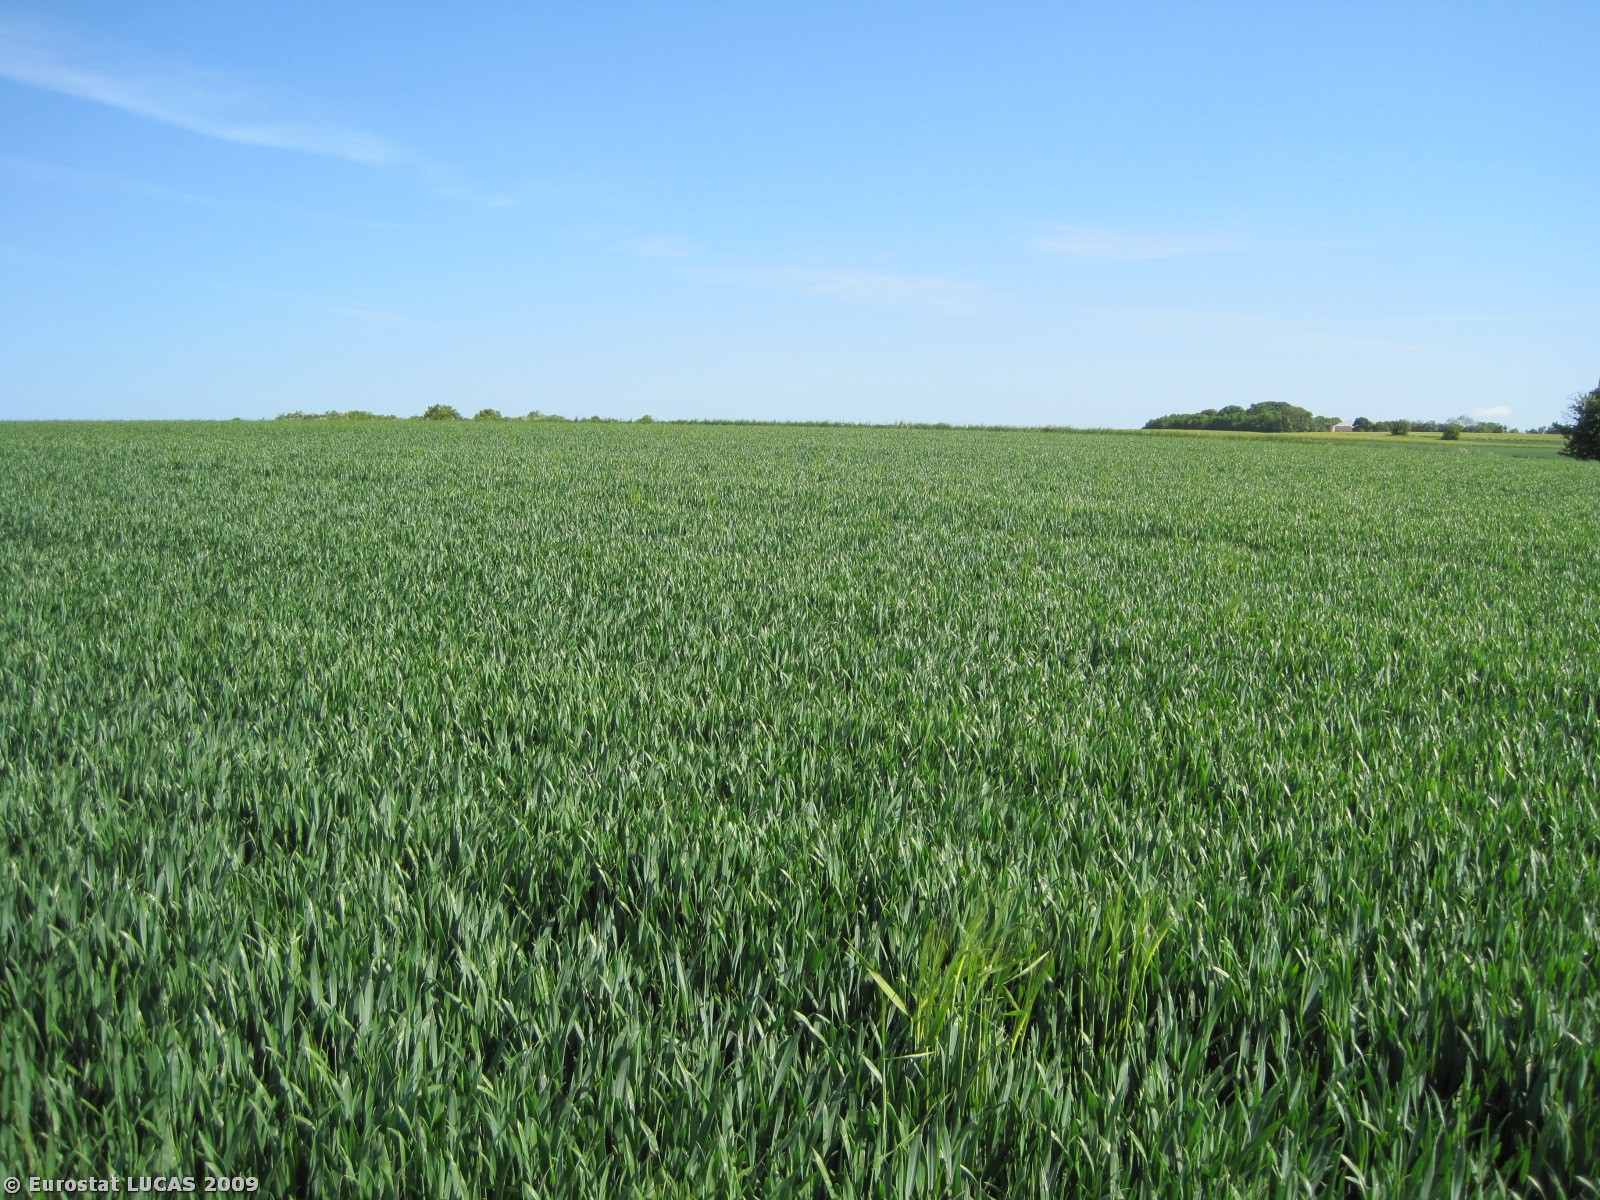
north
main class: Cropland
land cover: Common wheat
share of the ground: > 75 %
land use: Agriculture (excluding fallow land and kitchen gardens)
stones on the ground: < 10 %
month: May
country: DK
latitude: 56.4932
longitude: 10.1460
